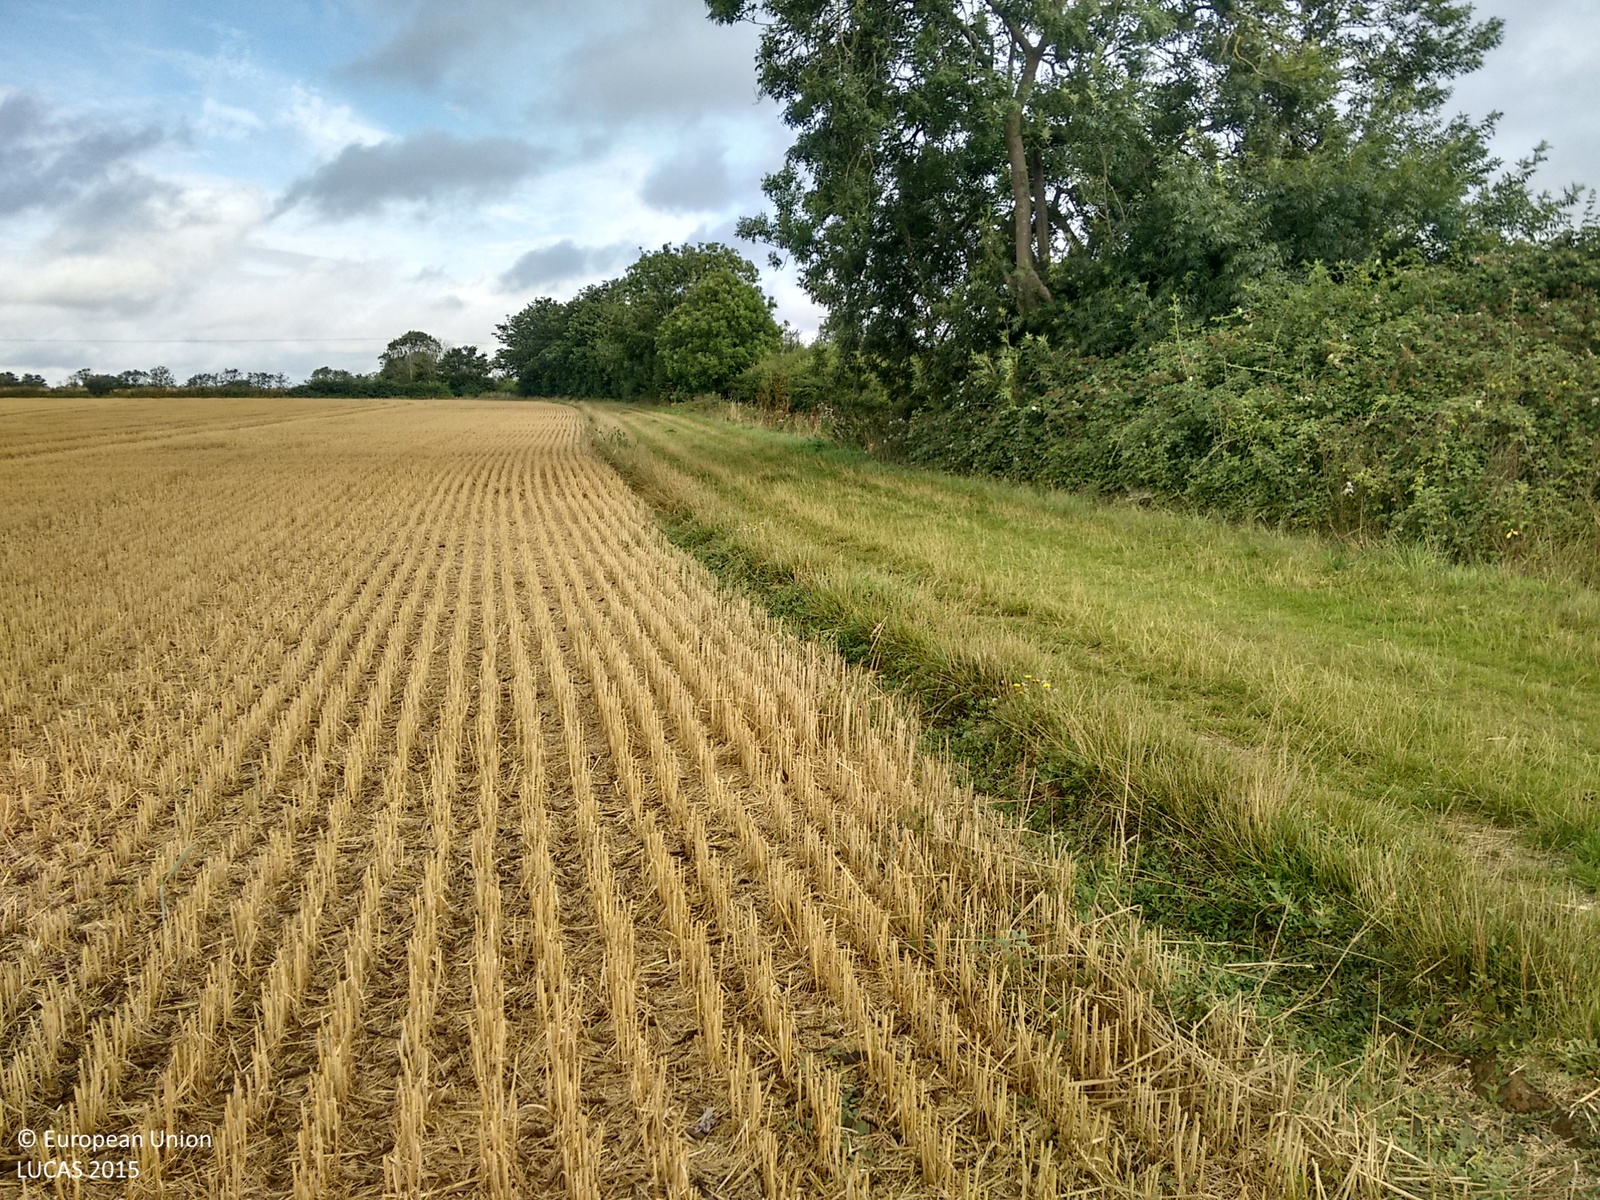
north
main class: Cropland
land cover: Common wheat
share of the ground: > 75 %
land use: Agriculture (excluding fallow land and kitchen gardens)
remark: Harvested field
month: August
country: GB
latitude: 52.1206
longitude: 0.9356
